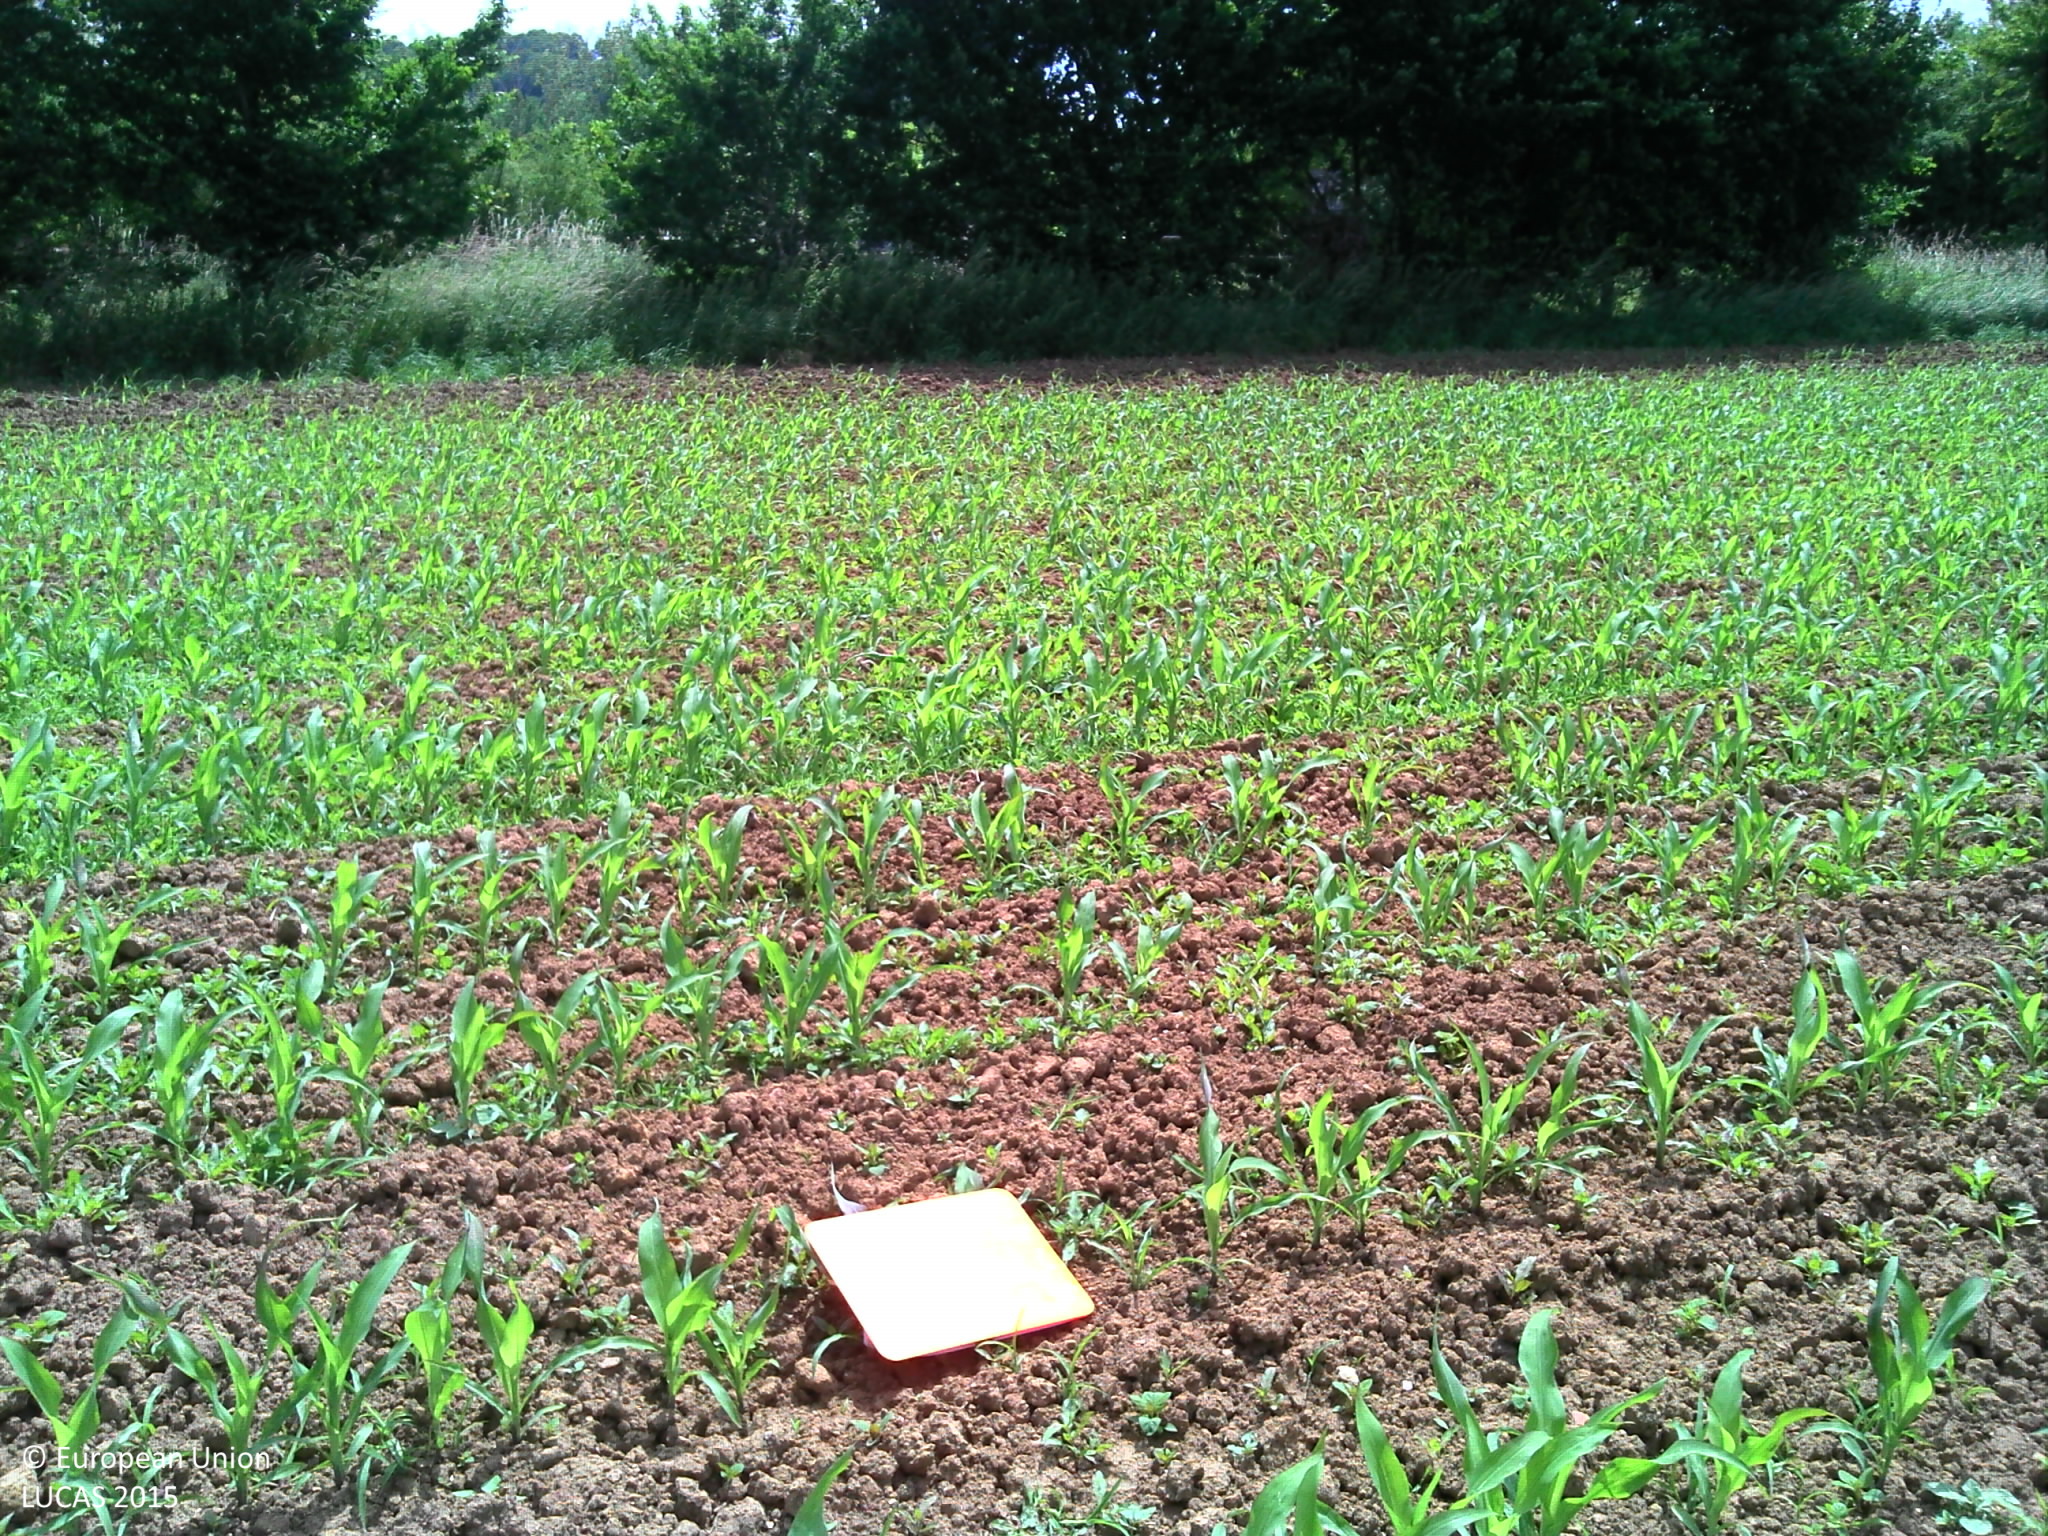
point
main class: Cropland
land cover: Maize
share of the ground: 10 - 25 %
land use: Agriculture (excluding fallow land and kitchen gardens)
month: June
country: FR
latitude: 49.1635
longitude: -0.0010
